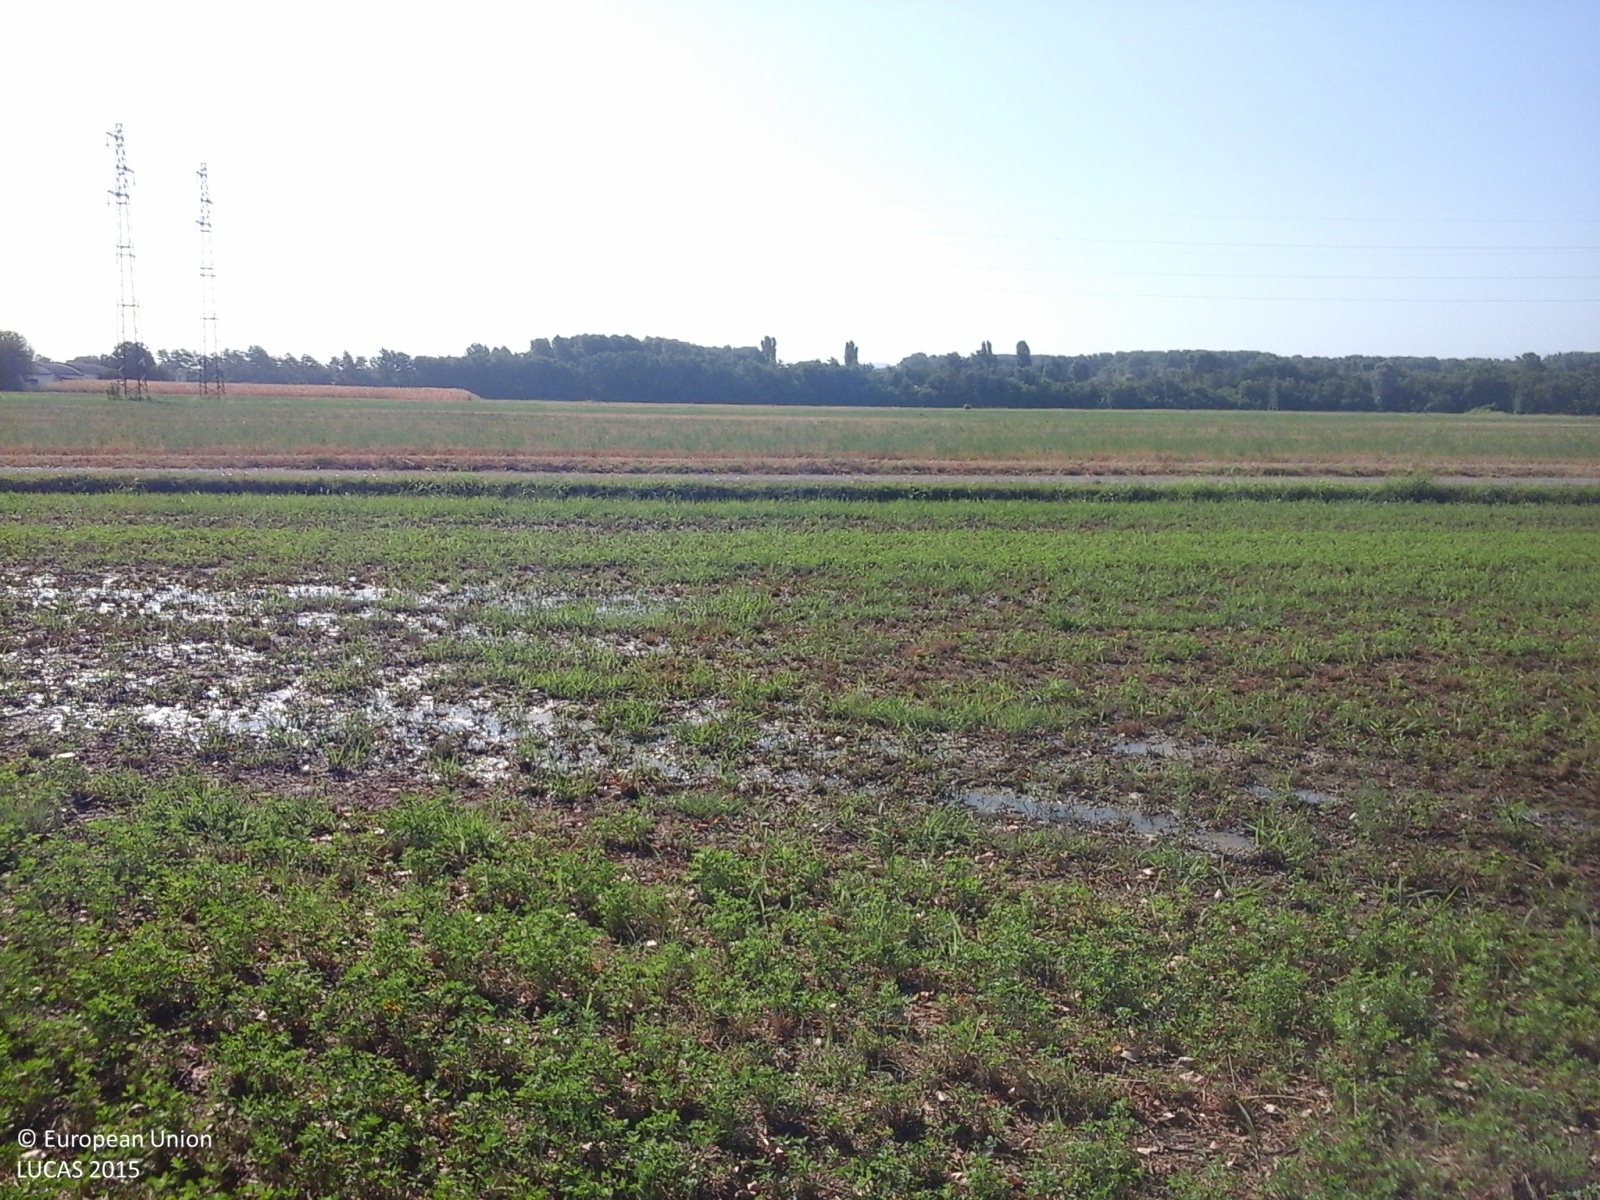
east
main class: Cropland
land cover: Lucerne
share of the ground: > 75 %
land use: Agriculture (excluding fallow land and kitchen gardens)
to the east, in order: Lucerne; Fences; Ditches and canals; Grass margins; Lucerne; Tracks; Common wheat; Grass margins; Lucerne; Grassland without tree/shrub cover; Electric lines; Common wheat
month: July
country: IT
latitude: 45.0860
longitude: 9.0997
